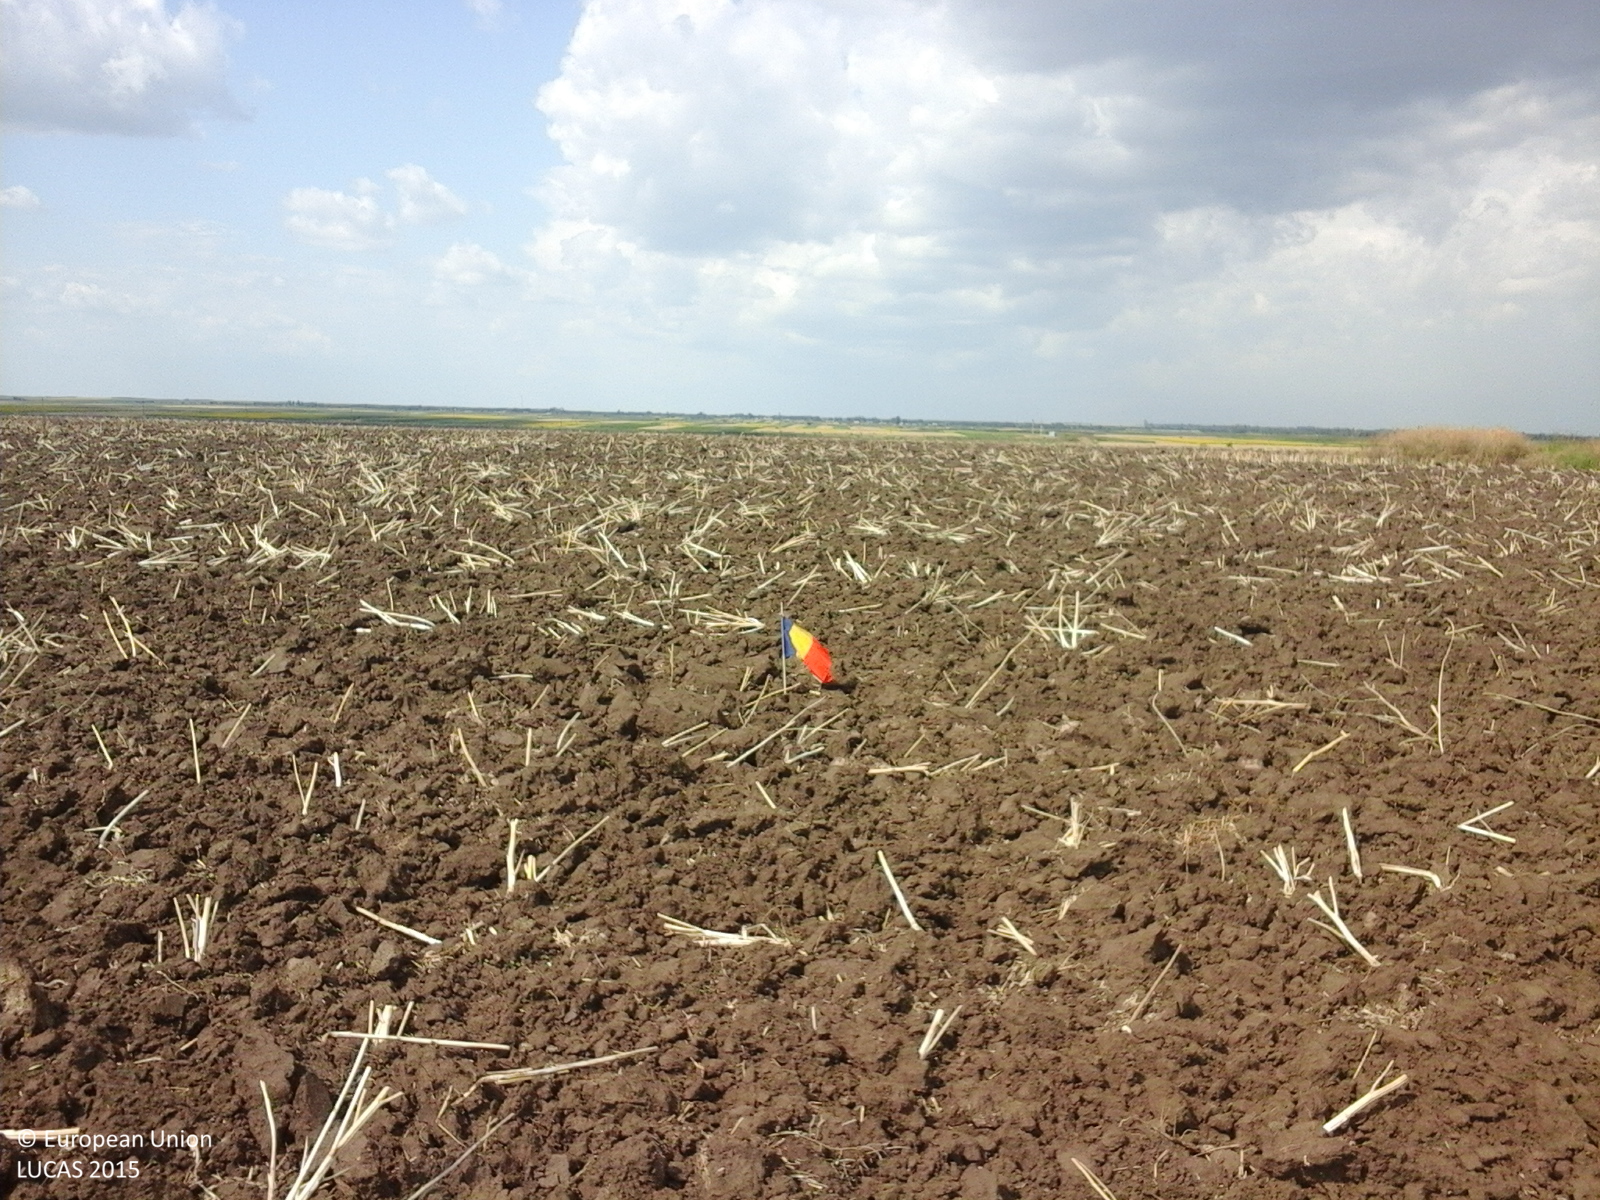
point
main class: Cropland
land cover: Rape and turnip rape
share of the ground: < 10 %
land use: Agriculture (excluding fallow land and kitchen gardens)
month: July
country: RO
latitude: 43.8088
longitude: 24.3197
